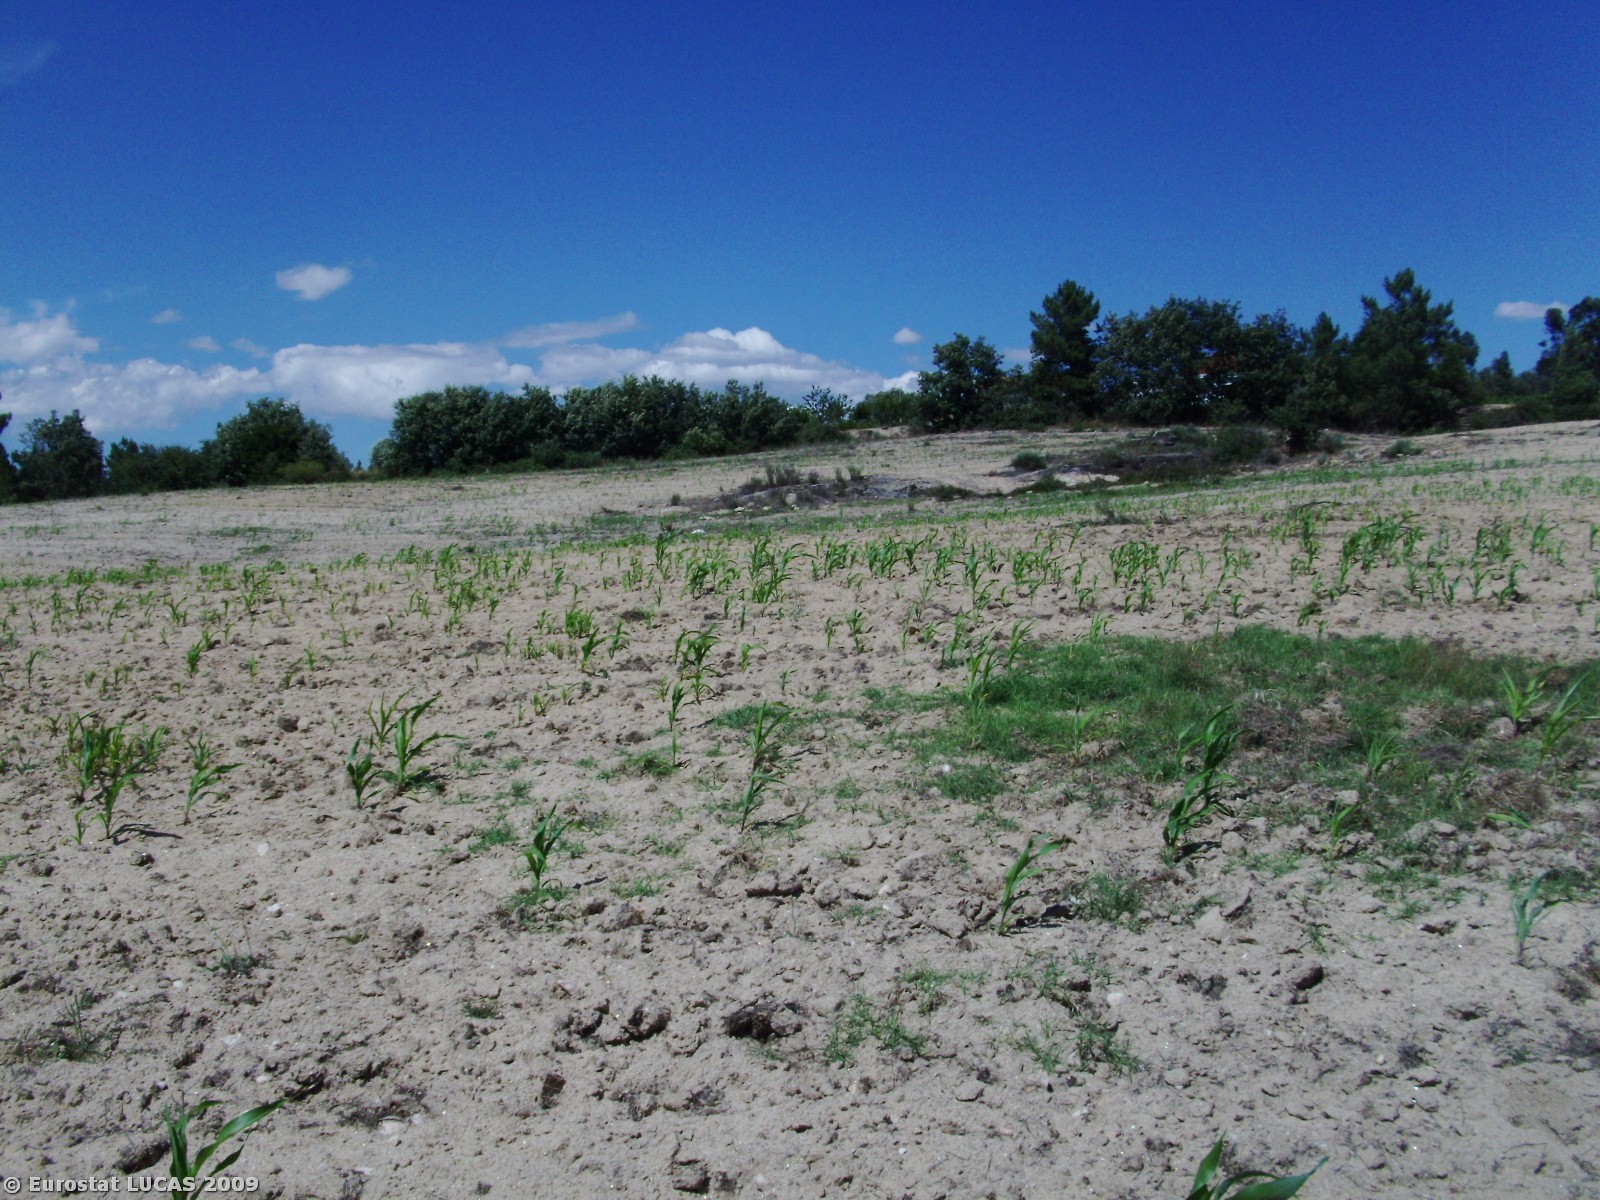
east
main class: Cropland
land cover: Maize
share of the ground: < 10 %
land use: Agriculture (excluding fallow land and kitchen gardens)
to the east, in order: Maize; Broadleaved woodland; Vineyards; Tracks; Vineyards
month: July
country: PT
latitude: 40.2712
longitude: -7.3794
